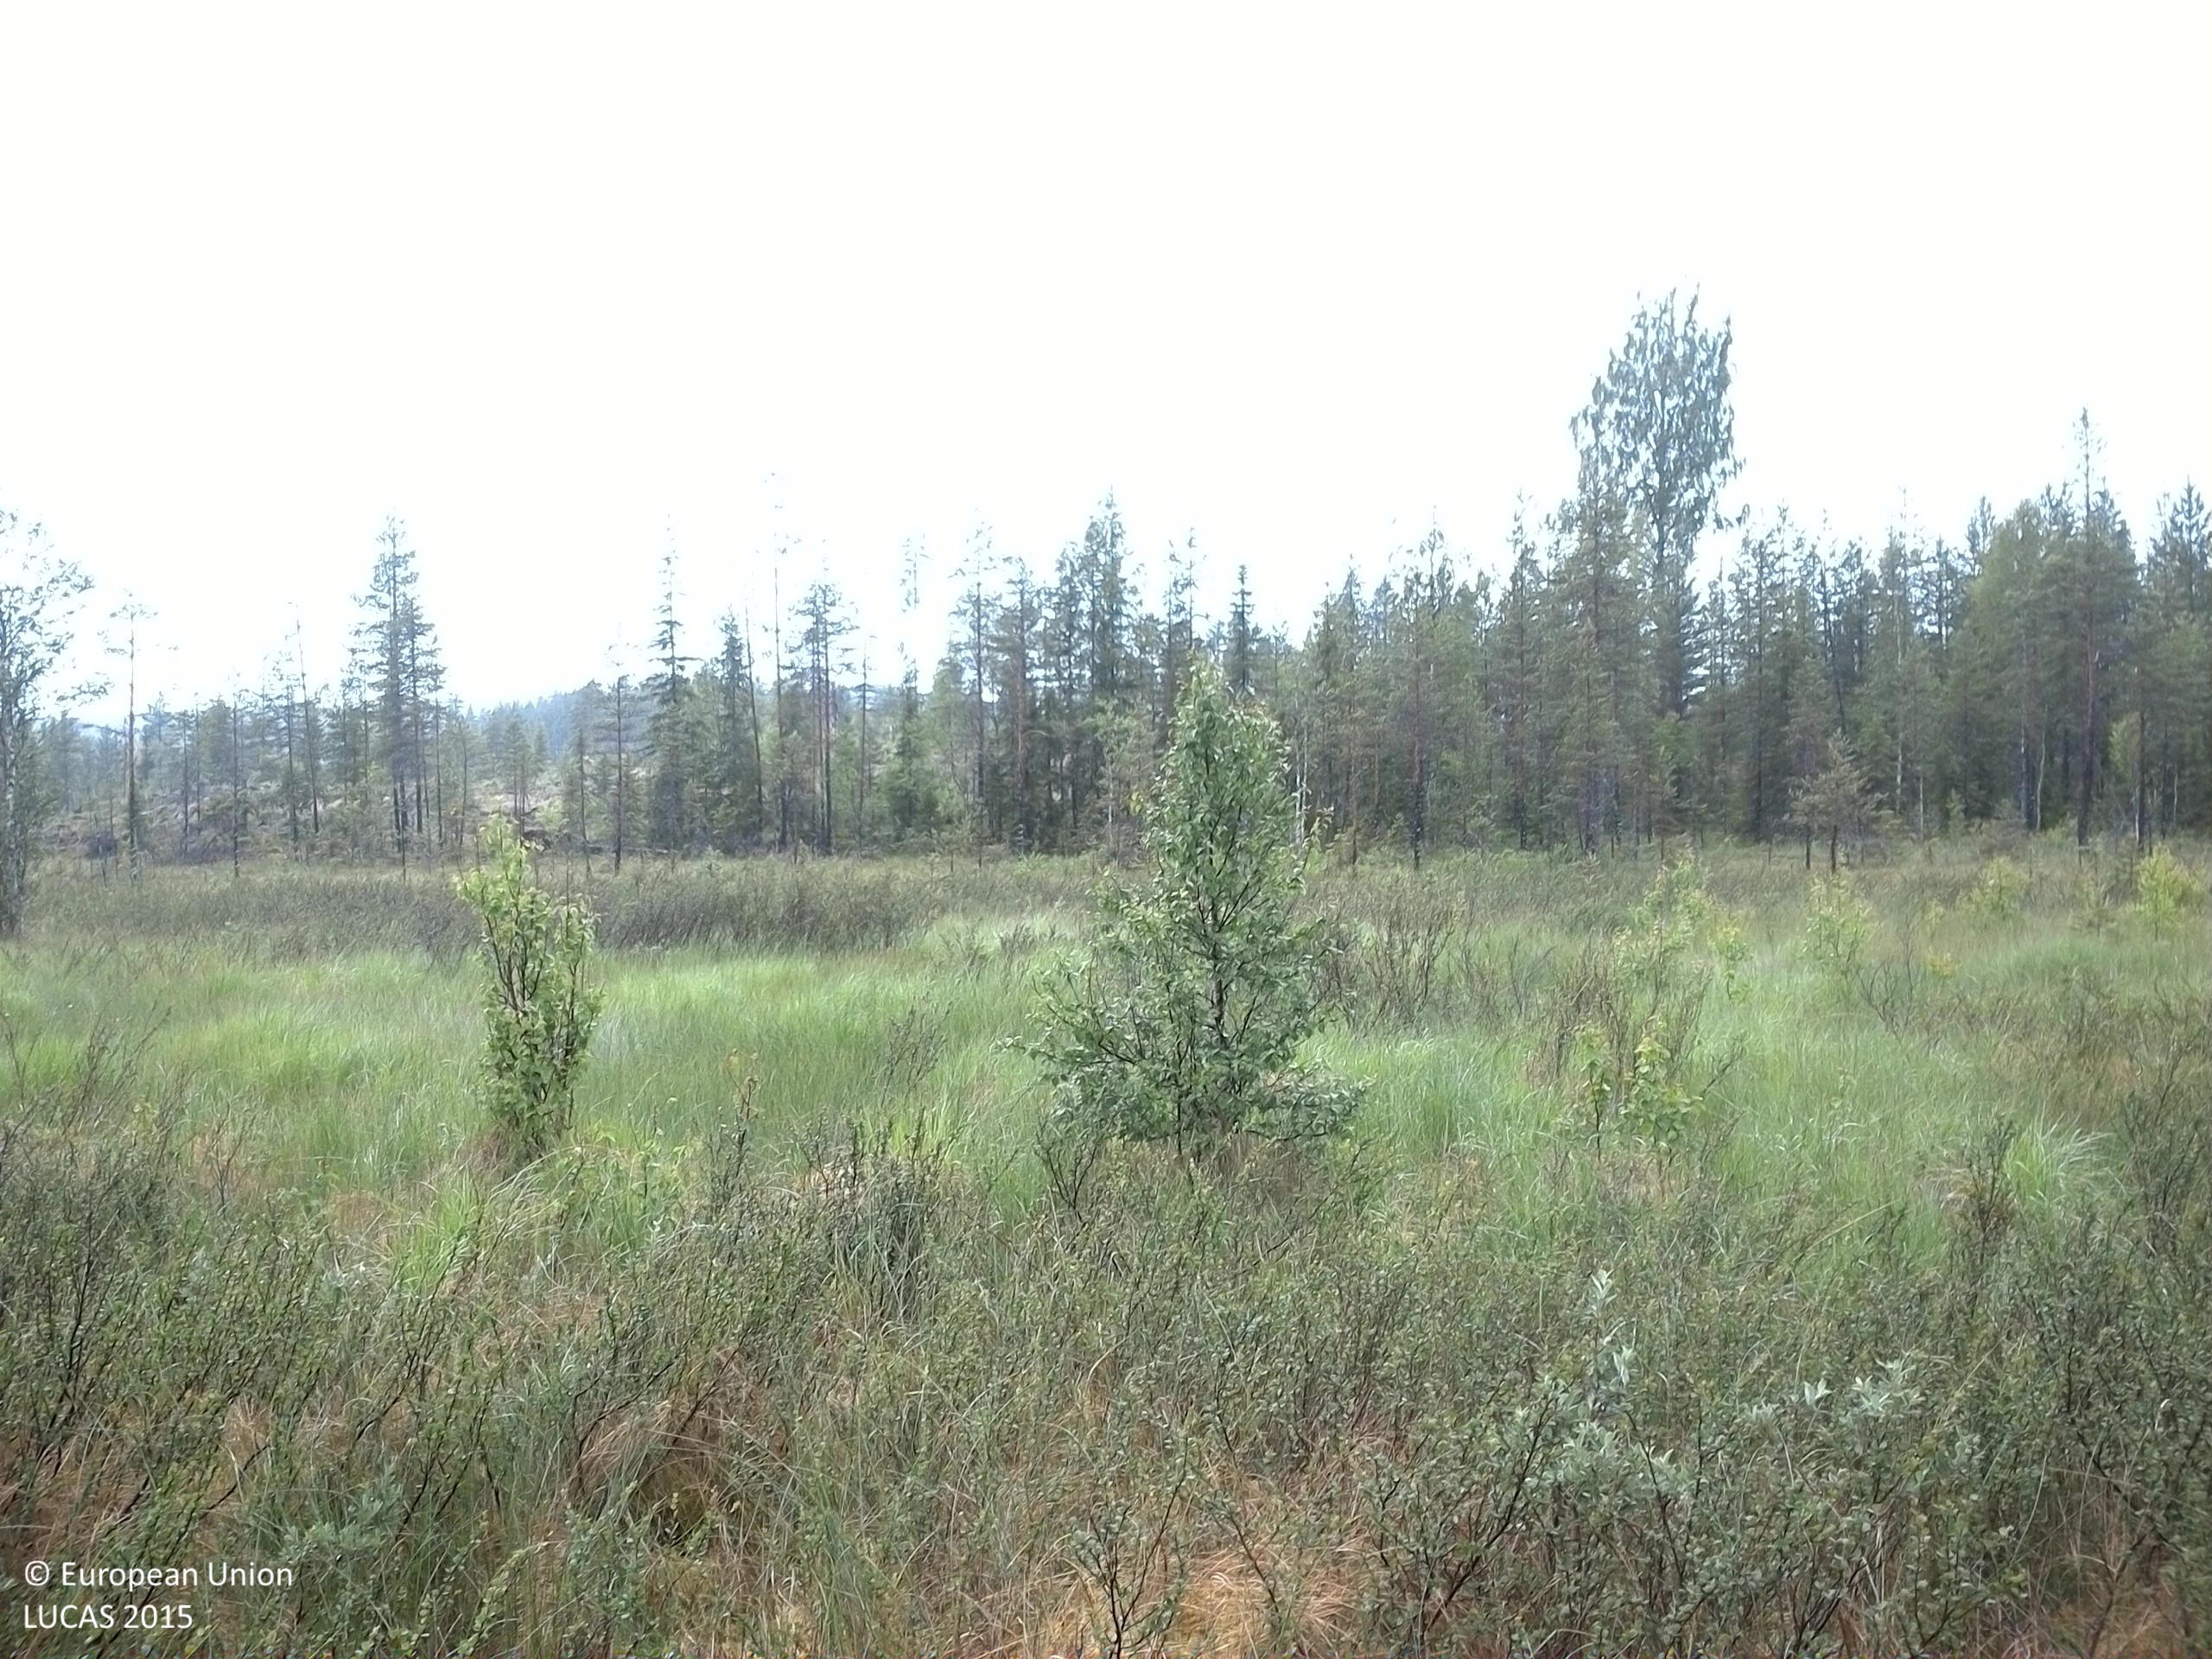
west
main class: Woodland
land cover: Pine dominated mixed woodland
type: boreal forest
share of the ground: 25 - 50 %
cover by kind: shrubs 40 %, lichens and mosses 20 %, coniferous forest trees 15 %, broadleaved forest trees 15 %, herbaceous plants 10 %
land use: Semi-natural and natural areas not in use
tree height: < 5 m
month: July
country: SE
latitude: 63.6656
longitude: 17.3475
